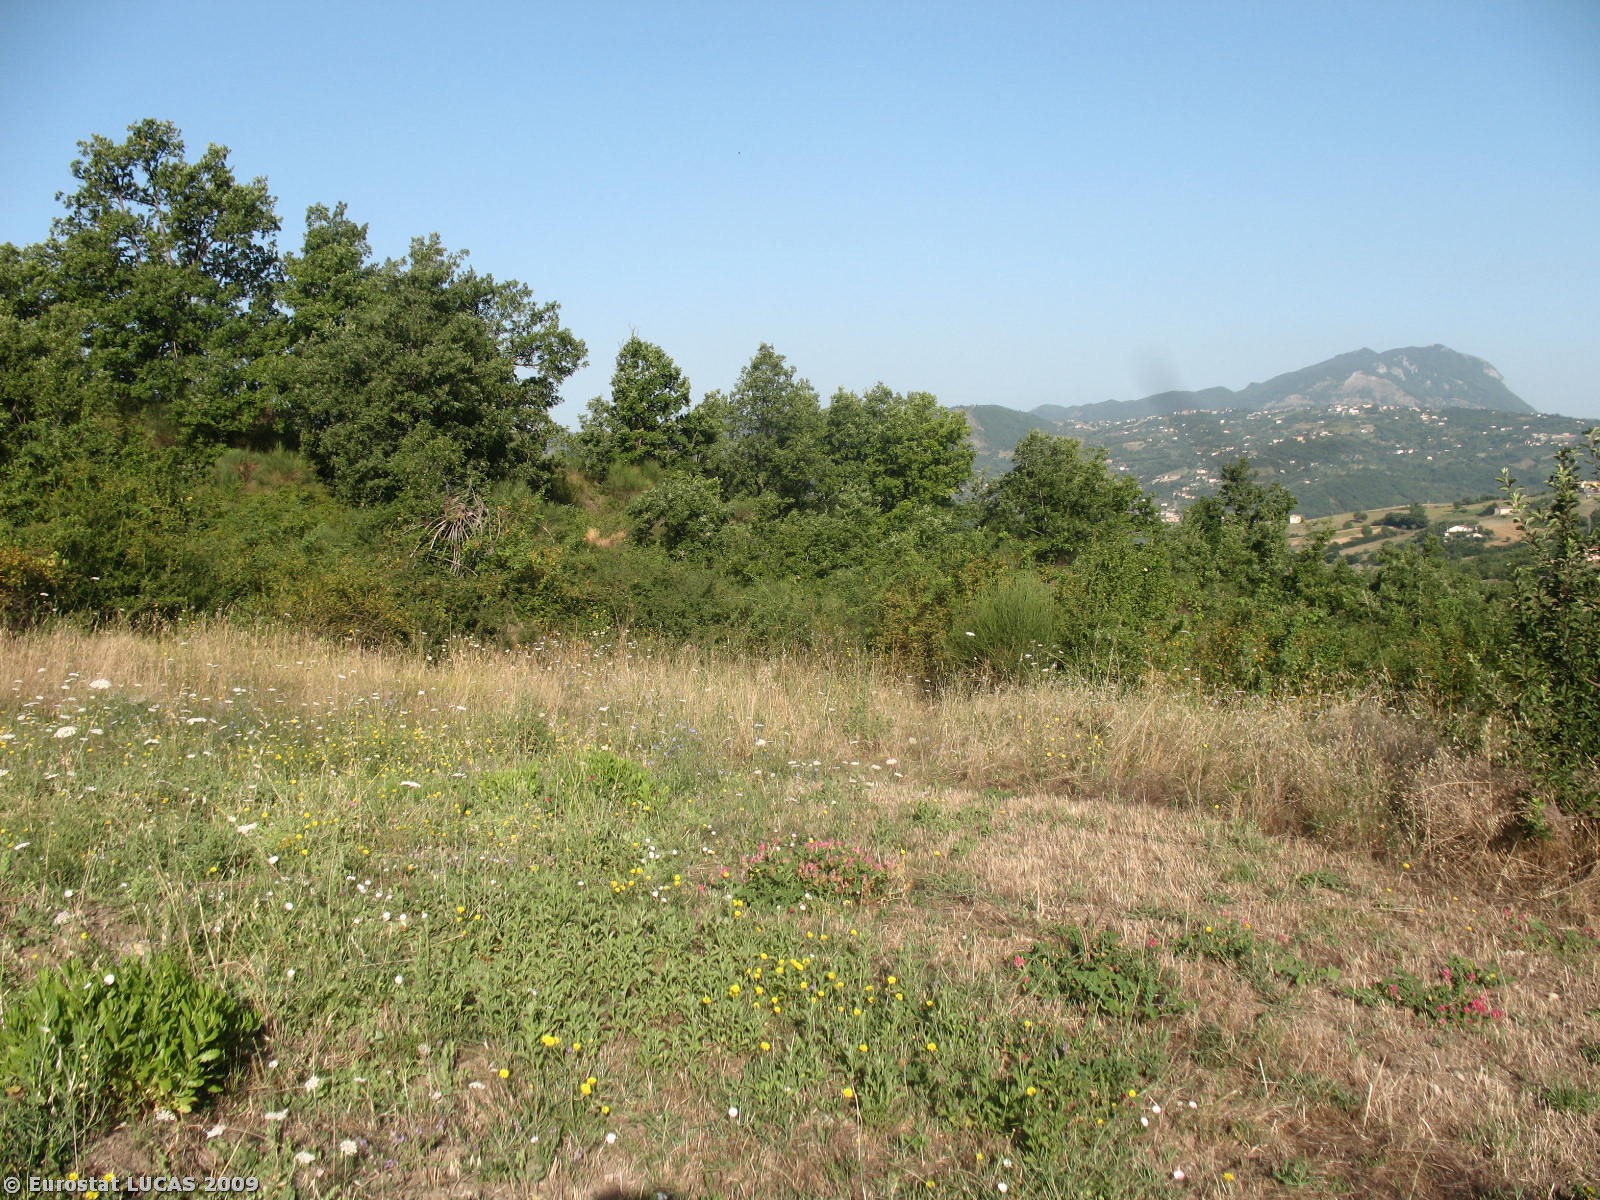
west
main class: Woodland
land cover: Broadleaved woodland
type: mesophytic deciduous forest
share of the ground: > 75 %
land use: Agriculture (excluding fallow land and kitchen gardens)
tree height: > 5 m
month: July
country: IT
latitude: 40.8974
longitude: 15.0725
